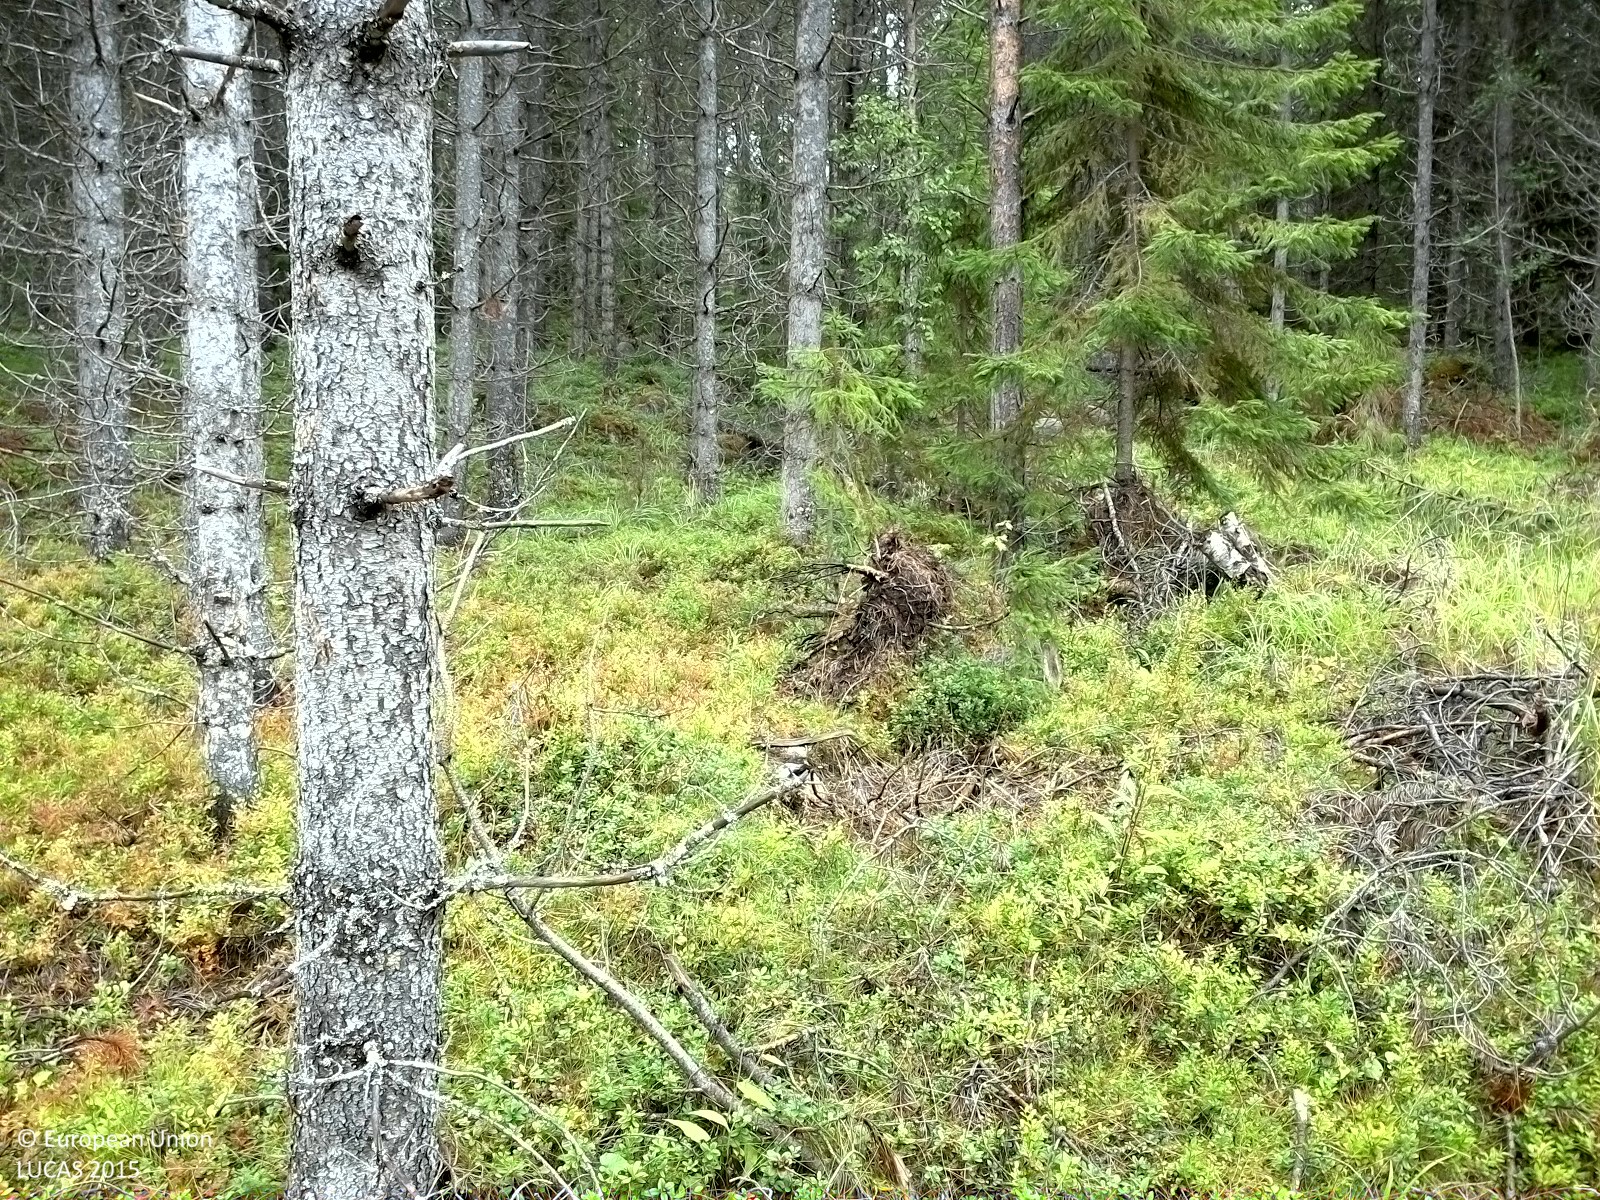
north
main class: Woodland
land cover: Pine dominated coniferous woodland
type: exotic forest
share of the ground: 25 - 50 %
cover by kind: coniferous forest trees 40 %, shrubs 35 %, herbaceous plants 25 %
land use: Forestry
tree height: > 5 m
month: August
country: SE
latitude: 62.6981
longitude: 16.2903
